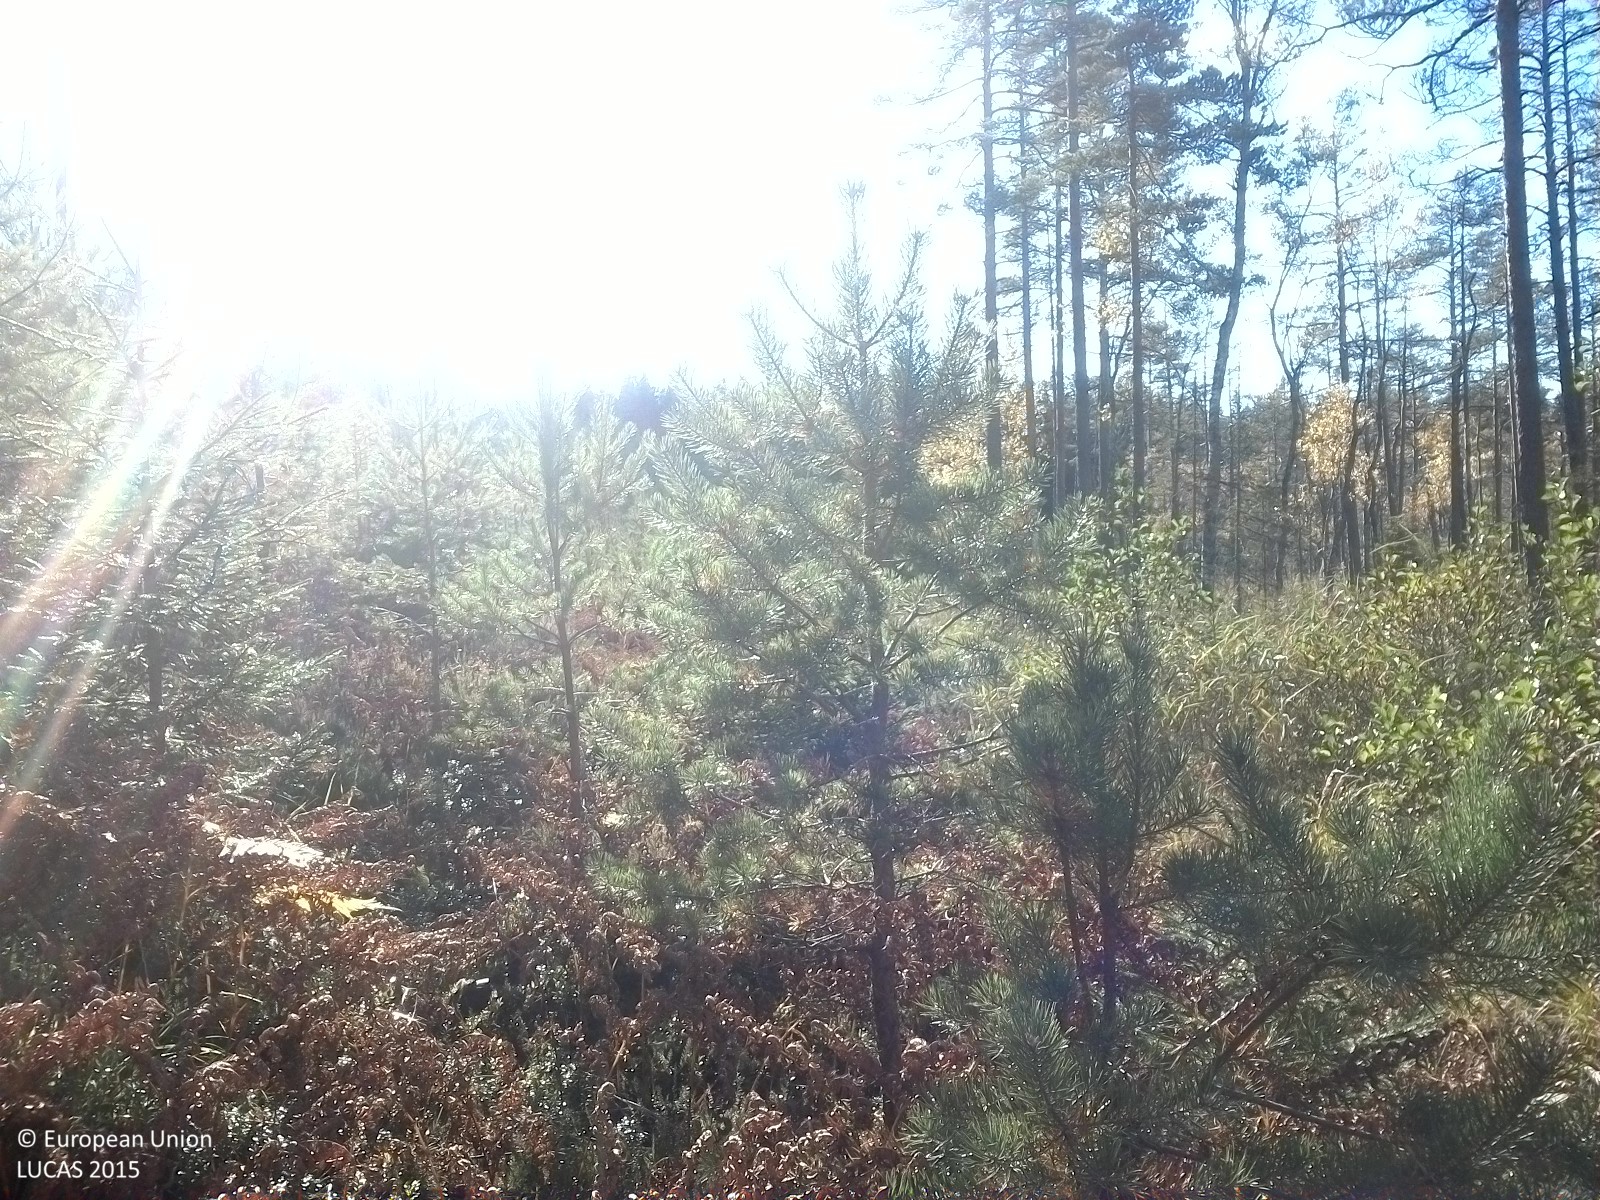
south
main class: Woodland
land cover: Pine dominated coniferous woodland
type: boreal forest
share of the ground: 25 - 50 %
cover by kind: herbaceous plants 50 %, coniferous forest trees 30 %, shrubs 10 %, lichens and mosses 10 %
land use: Forestry
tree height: < 5 m
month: September
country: SE
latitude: 58.7396
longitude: 16.3010
